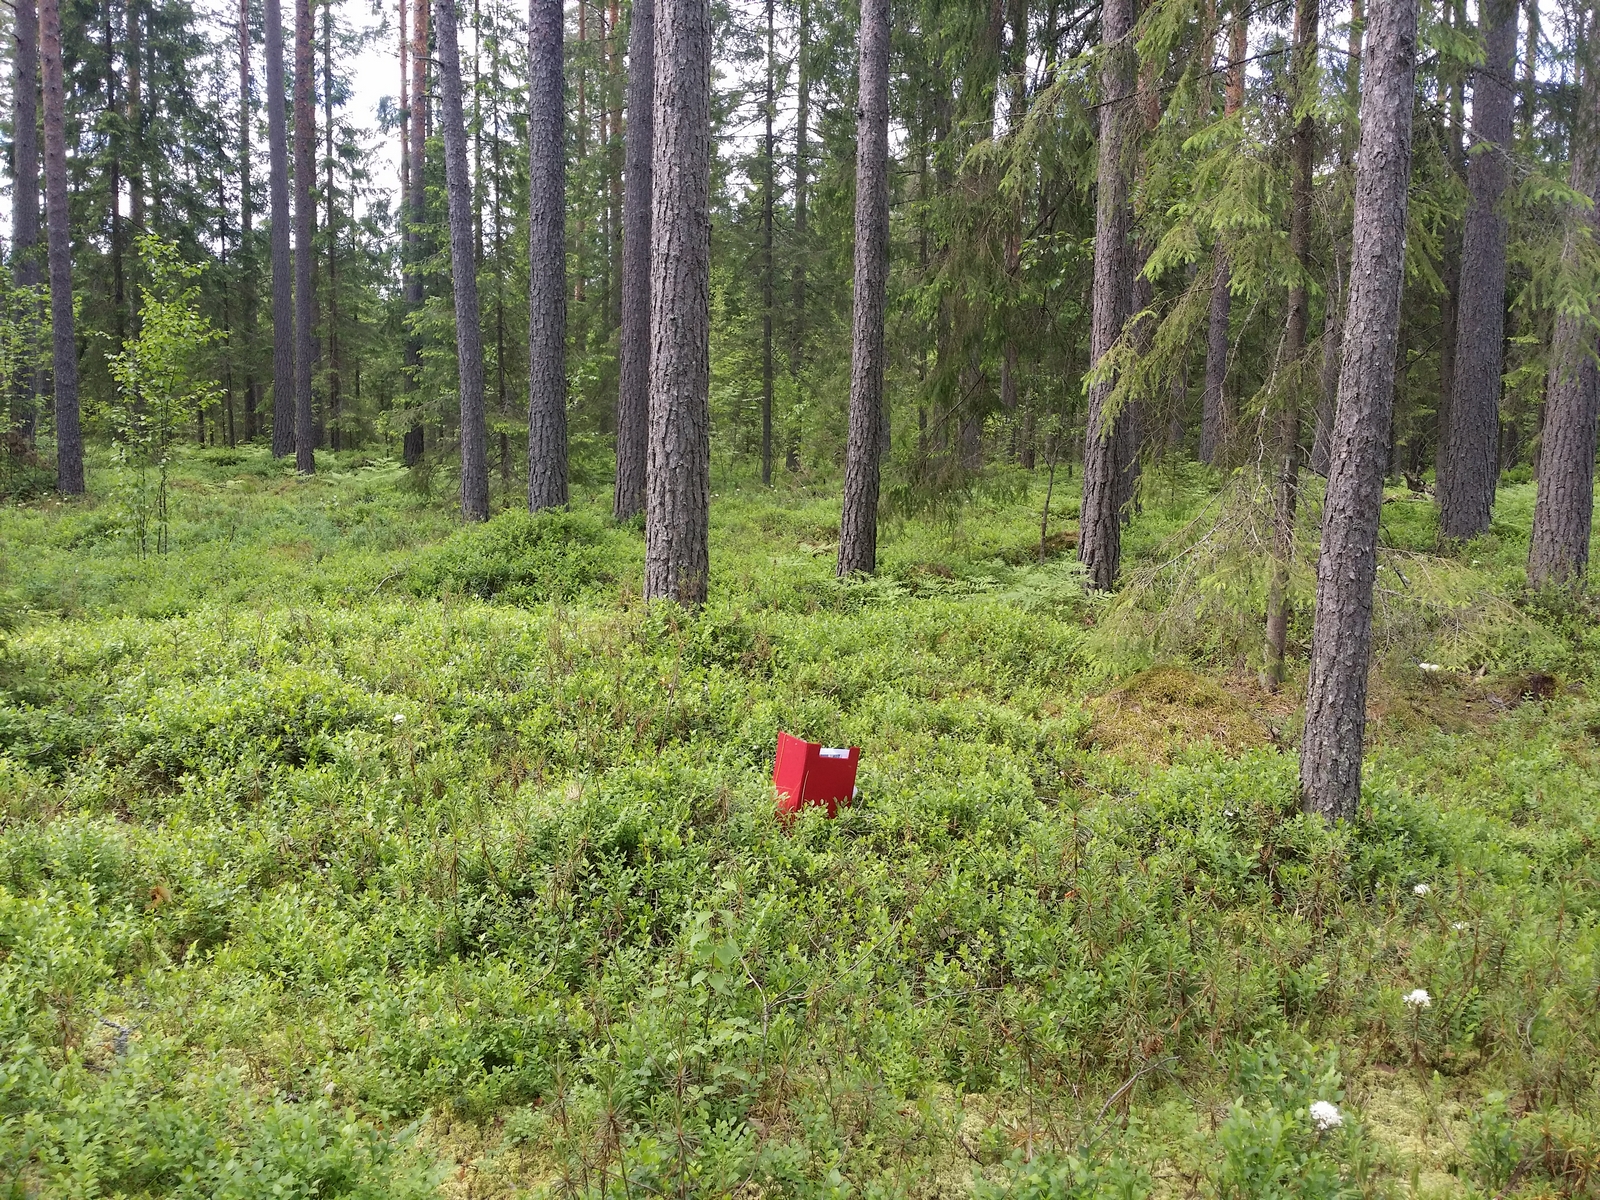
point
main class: Woodland
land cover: Other coniferous woodland
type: hemiboreal forest and nemoral coniferous forest and mixed broadleaved-coniferous forest
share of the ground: 50 - 75 %
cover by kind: coniferous forest trees 65 %, lichens and mosses 25 %, herbaceous plants 10 %
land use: Forestry
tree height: > 5 m
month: June
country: LV
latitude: 57.2869
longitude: 26.4509
